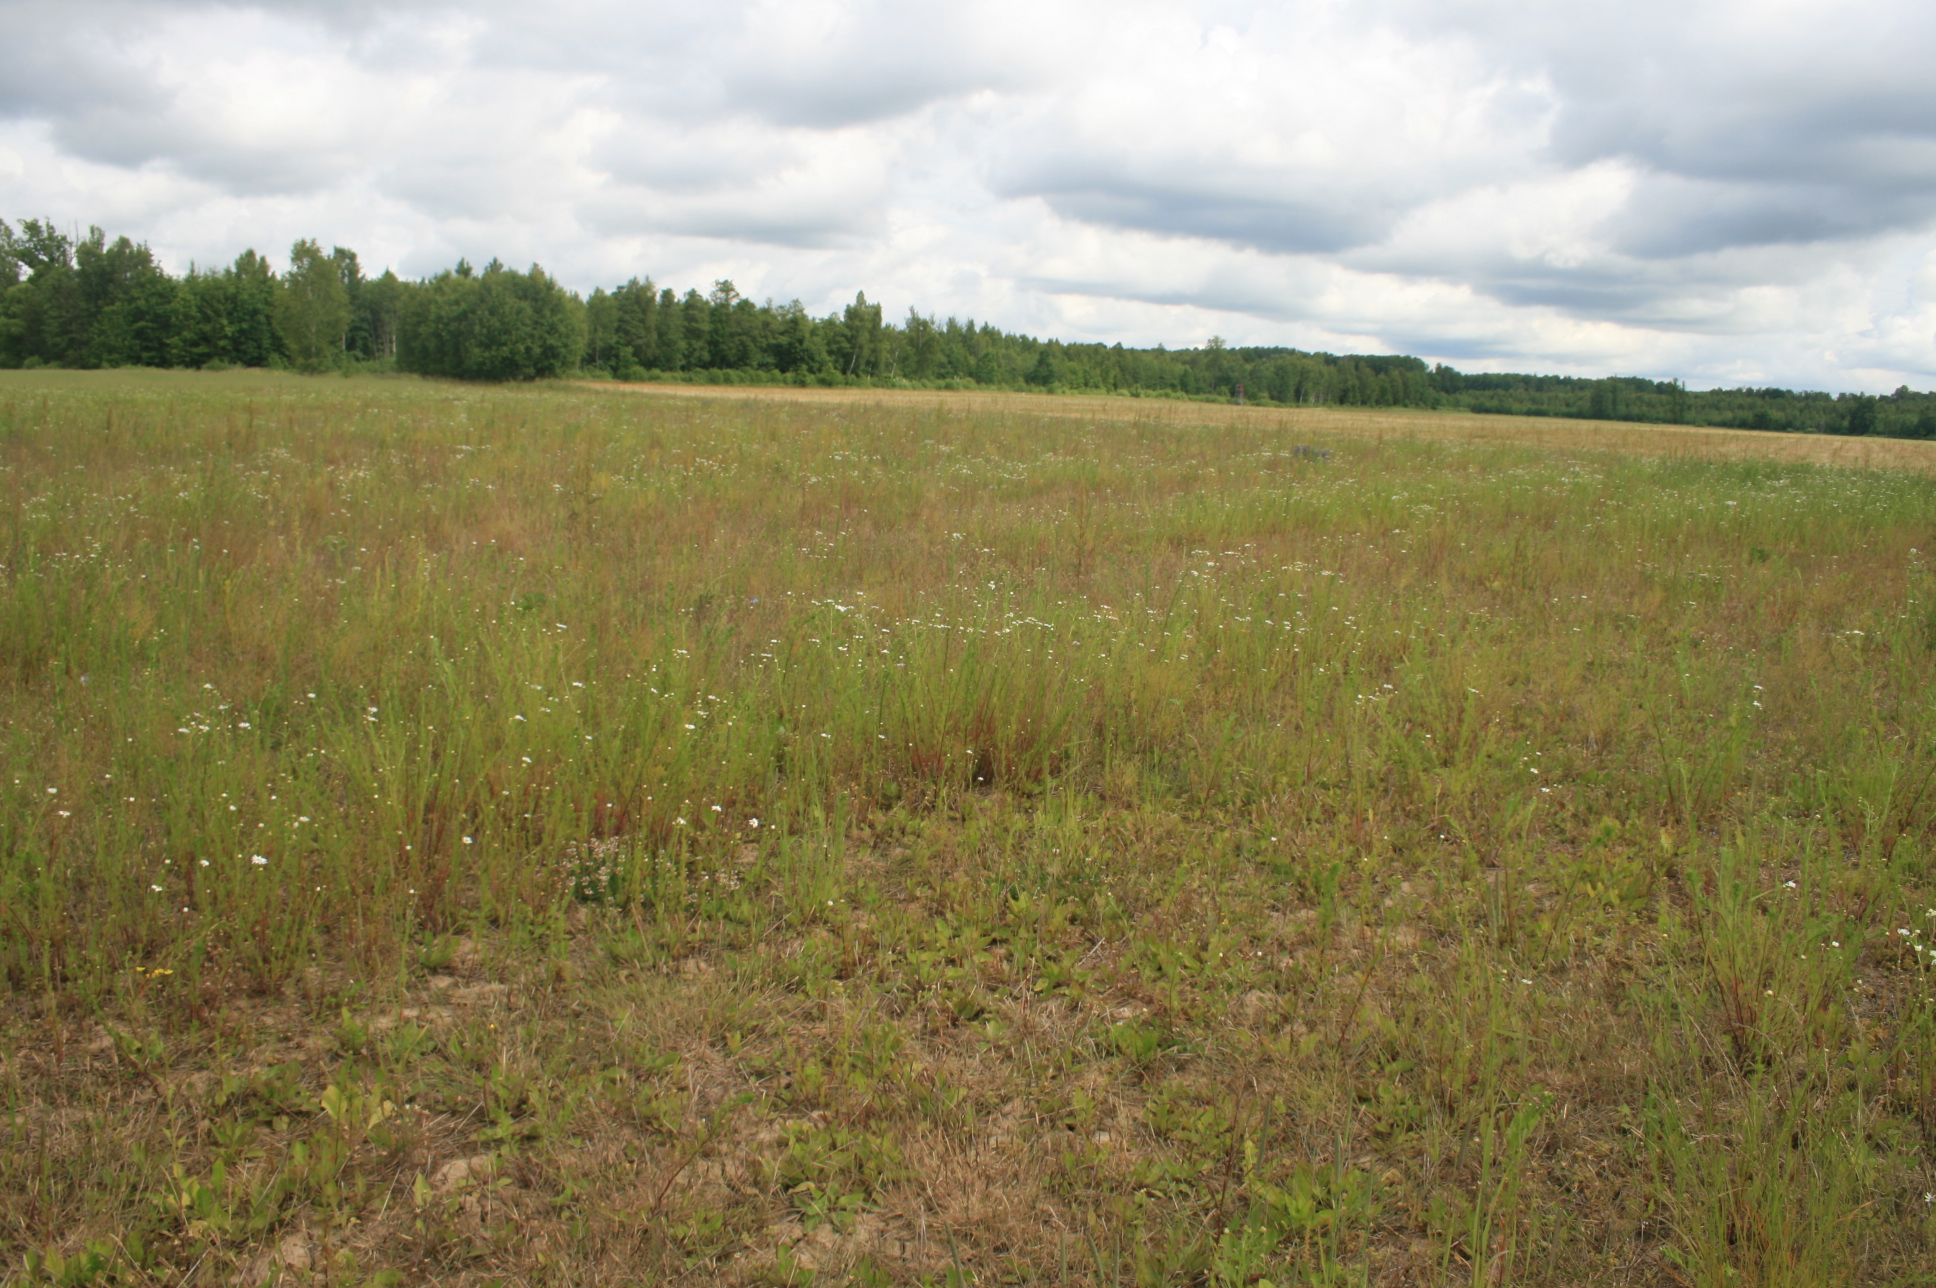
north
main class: Grassland
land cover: Spontaneously vegetated surfaces
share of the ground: > 75 %
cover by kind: herbaceous plants 90 %, unconsolidated bare surface 10 %
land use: Fallow land
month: June
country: LT
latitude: 55.3582
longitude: 22.2828
